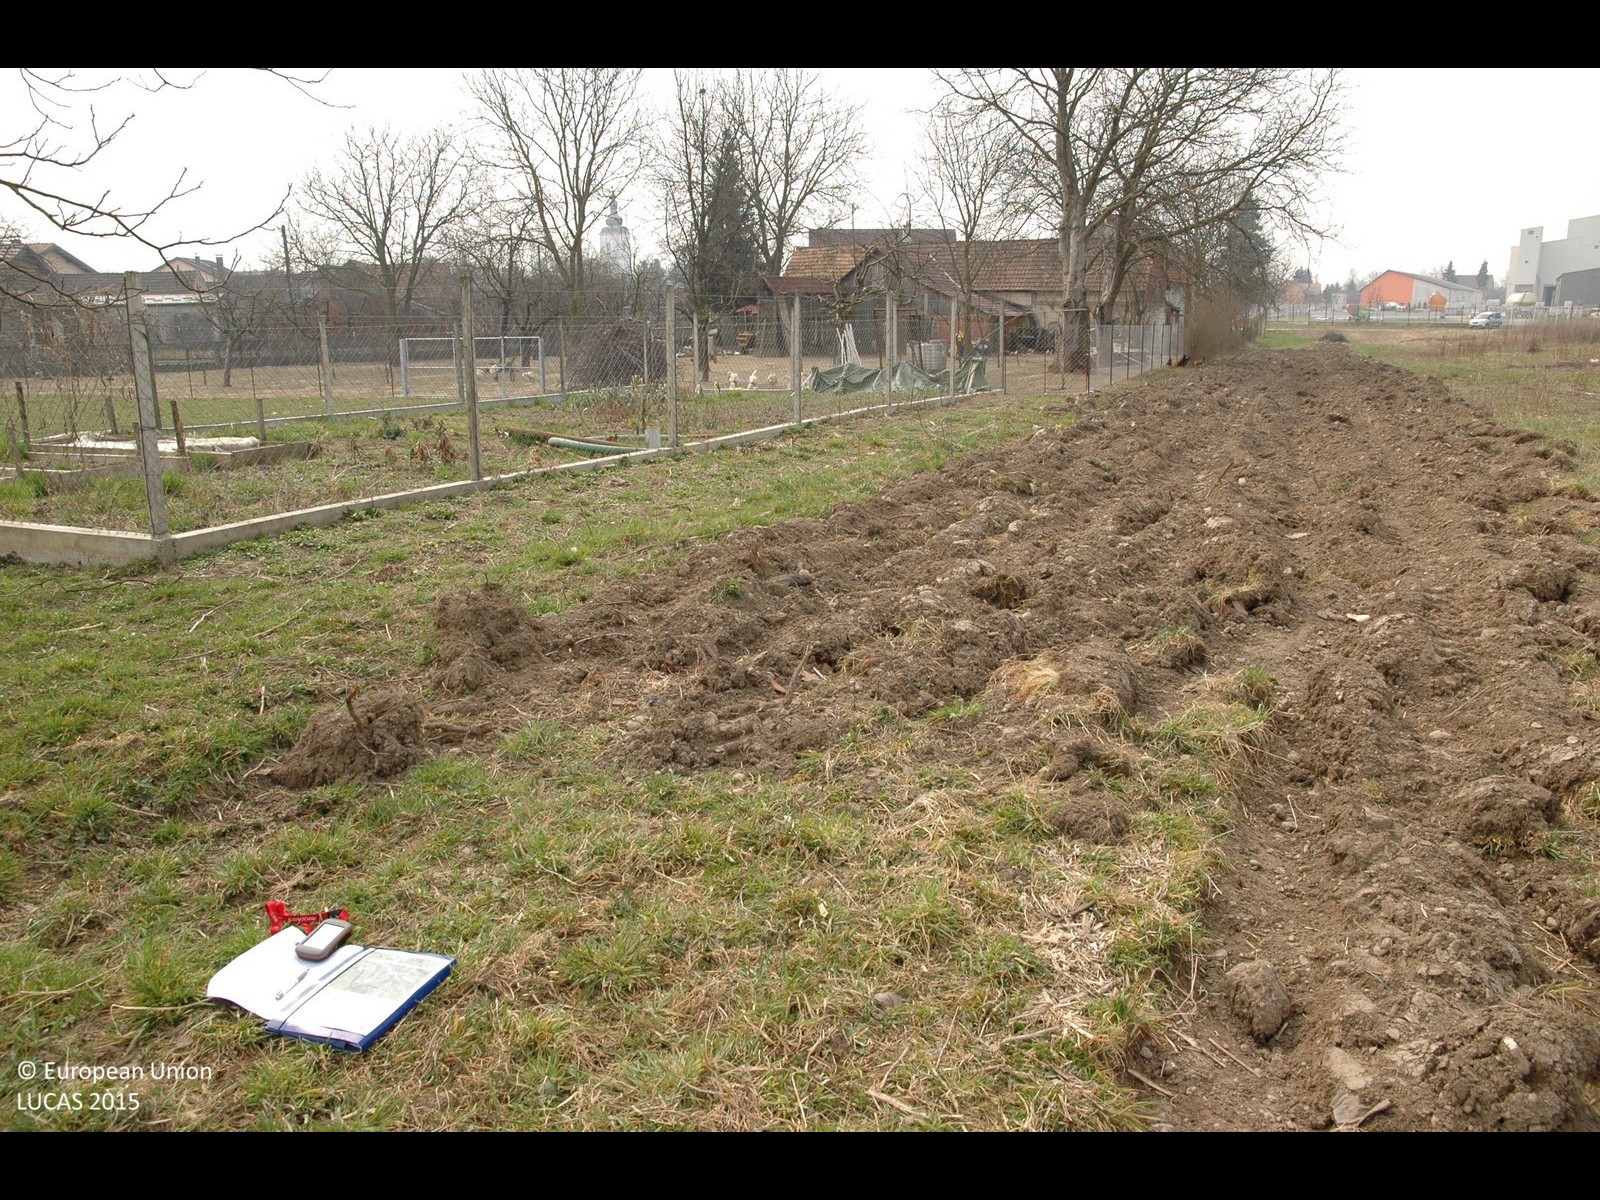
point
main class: Grassland
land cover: Grassland with sparse tree/shrub cover
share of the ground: > 75 %
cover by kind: herbaceous plants 95 %, broadleaved forest trees 5 %
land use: Agriculture (excluding fallow land and kitchen gardens)
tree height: > 5 m
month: March
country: HR
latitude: 46.3505
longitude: 16.2244
